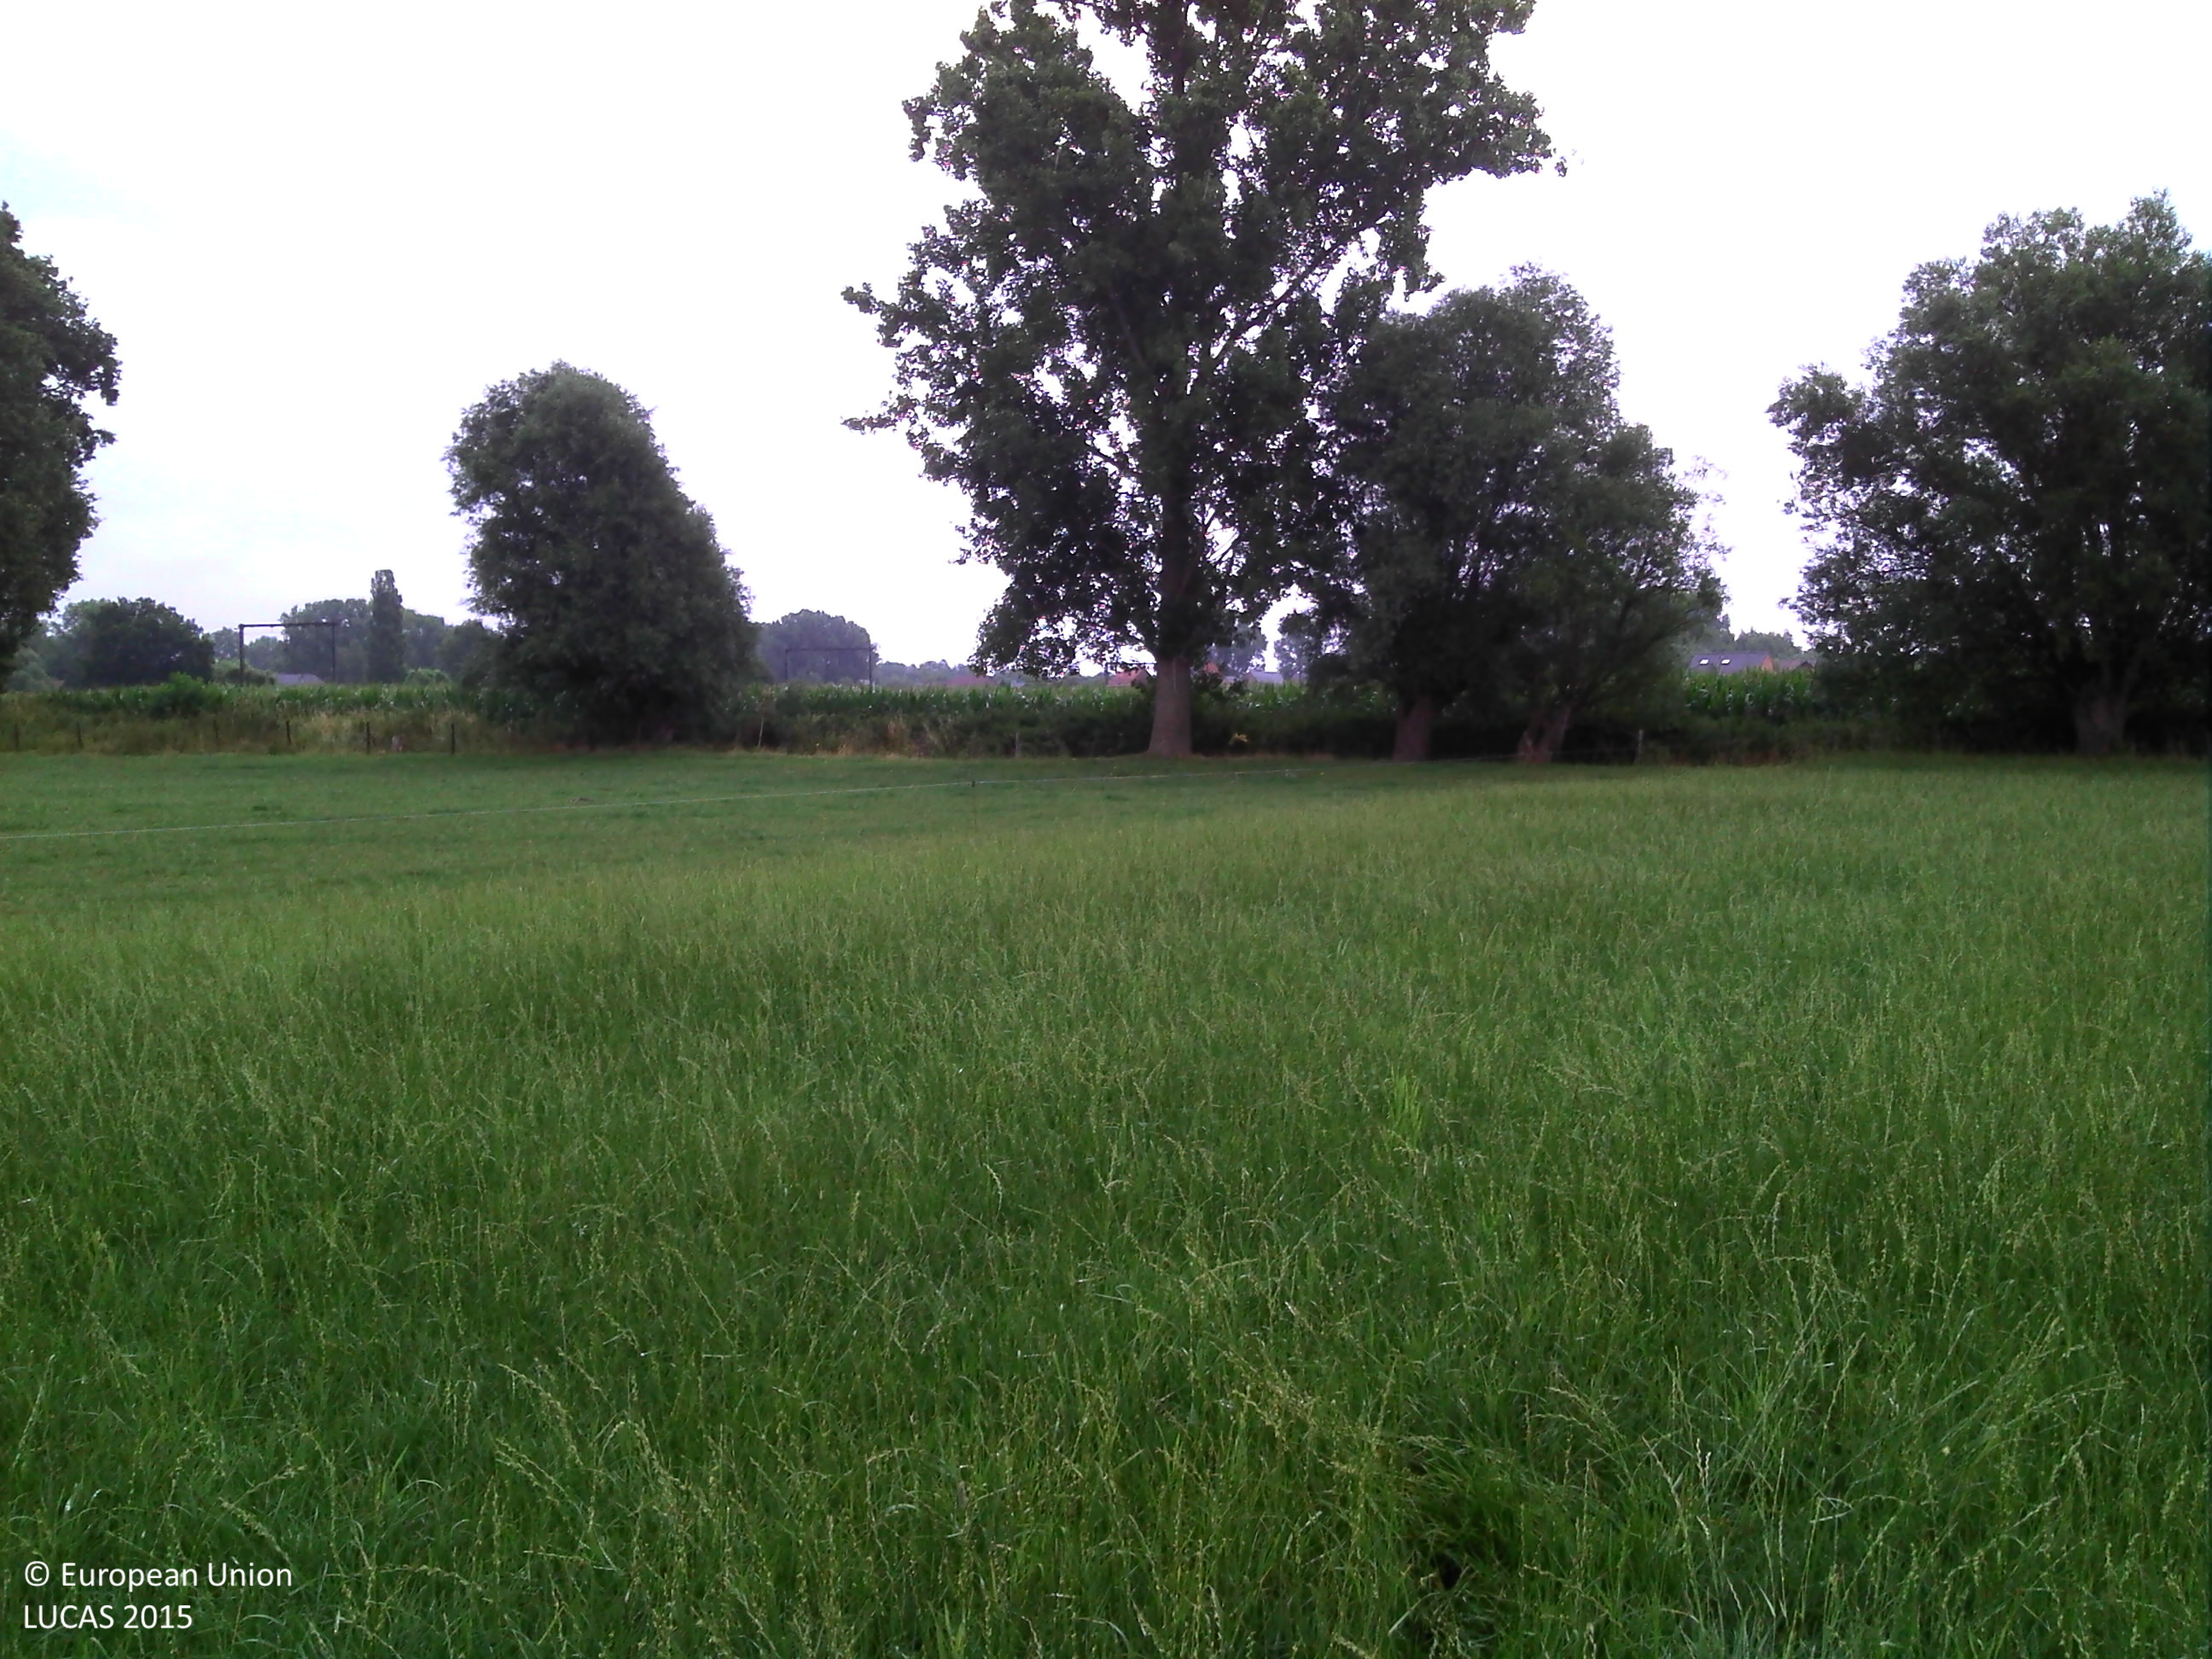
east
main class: Cropland
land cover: Temporary grasslands
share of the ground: > 75 %
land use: Agriculture (excluding fallow land and kitchen gardens)
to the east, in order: Temporary grasslands; Fences; Temporary grasslands; Fences; Lines of trees; Ditches and canals; Grass margins; Maize
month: July
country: BE
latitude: 50.8875
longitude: 5.4919
